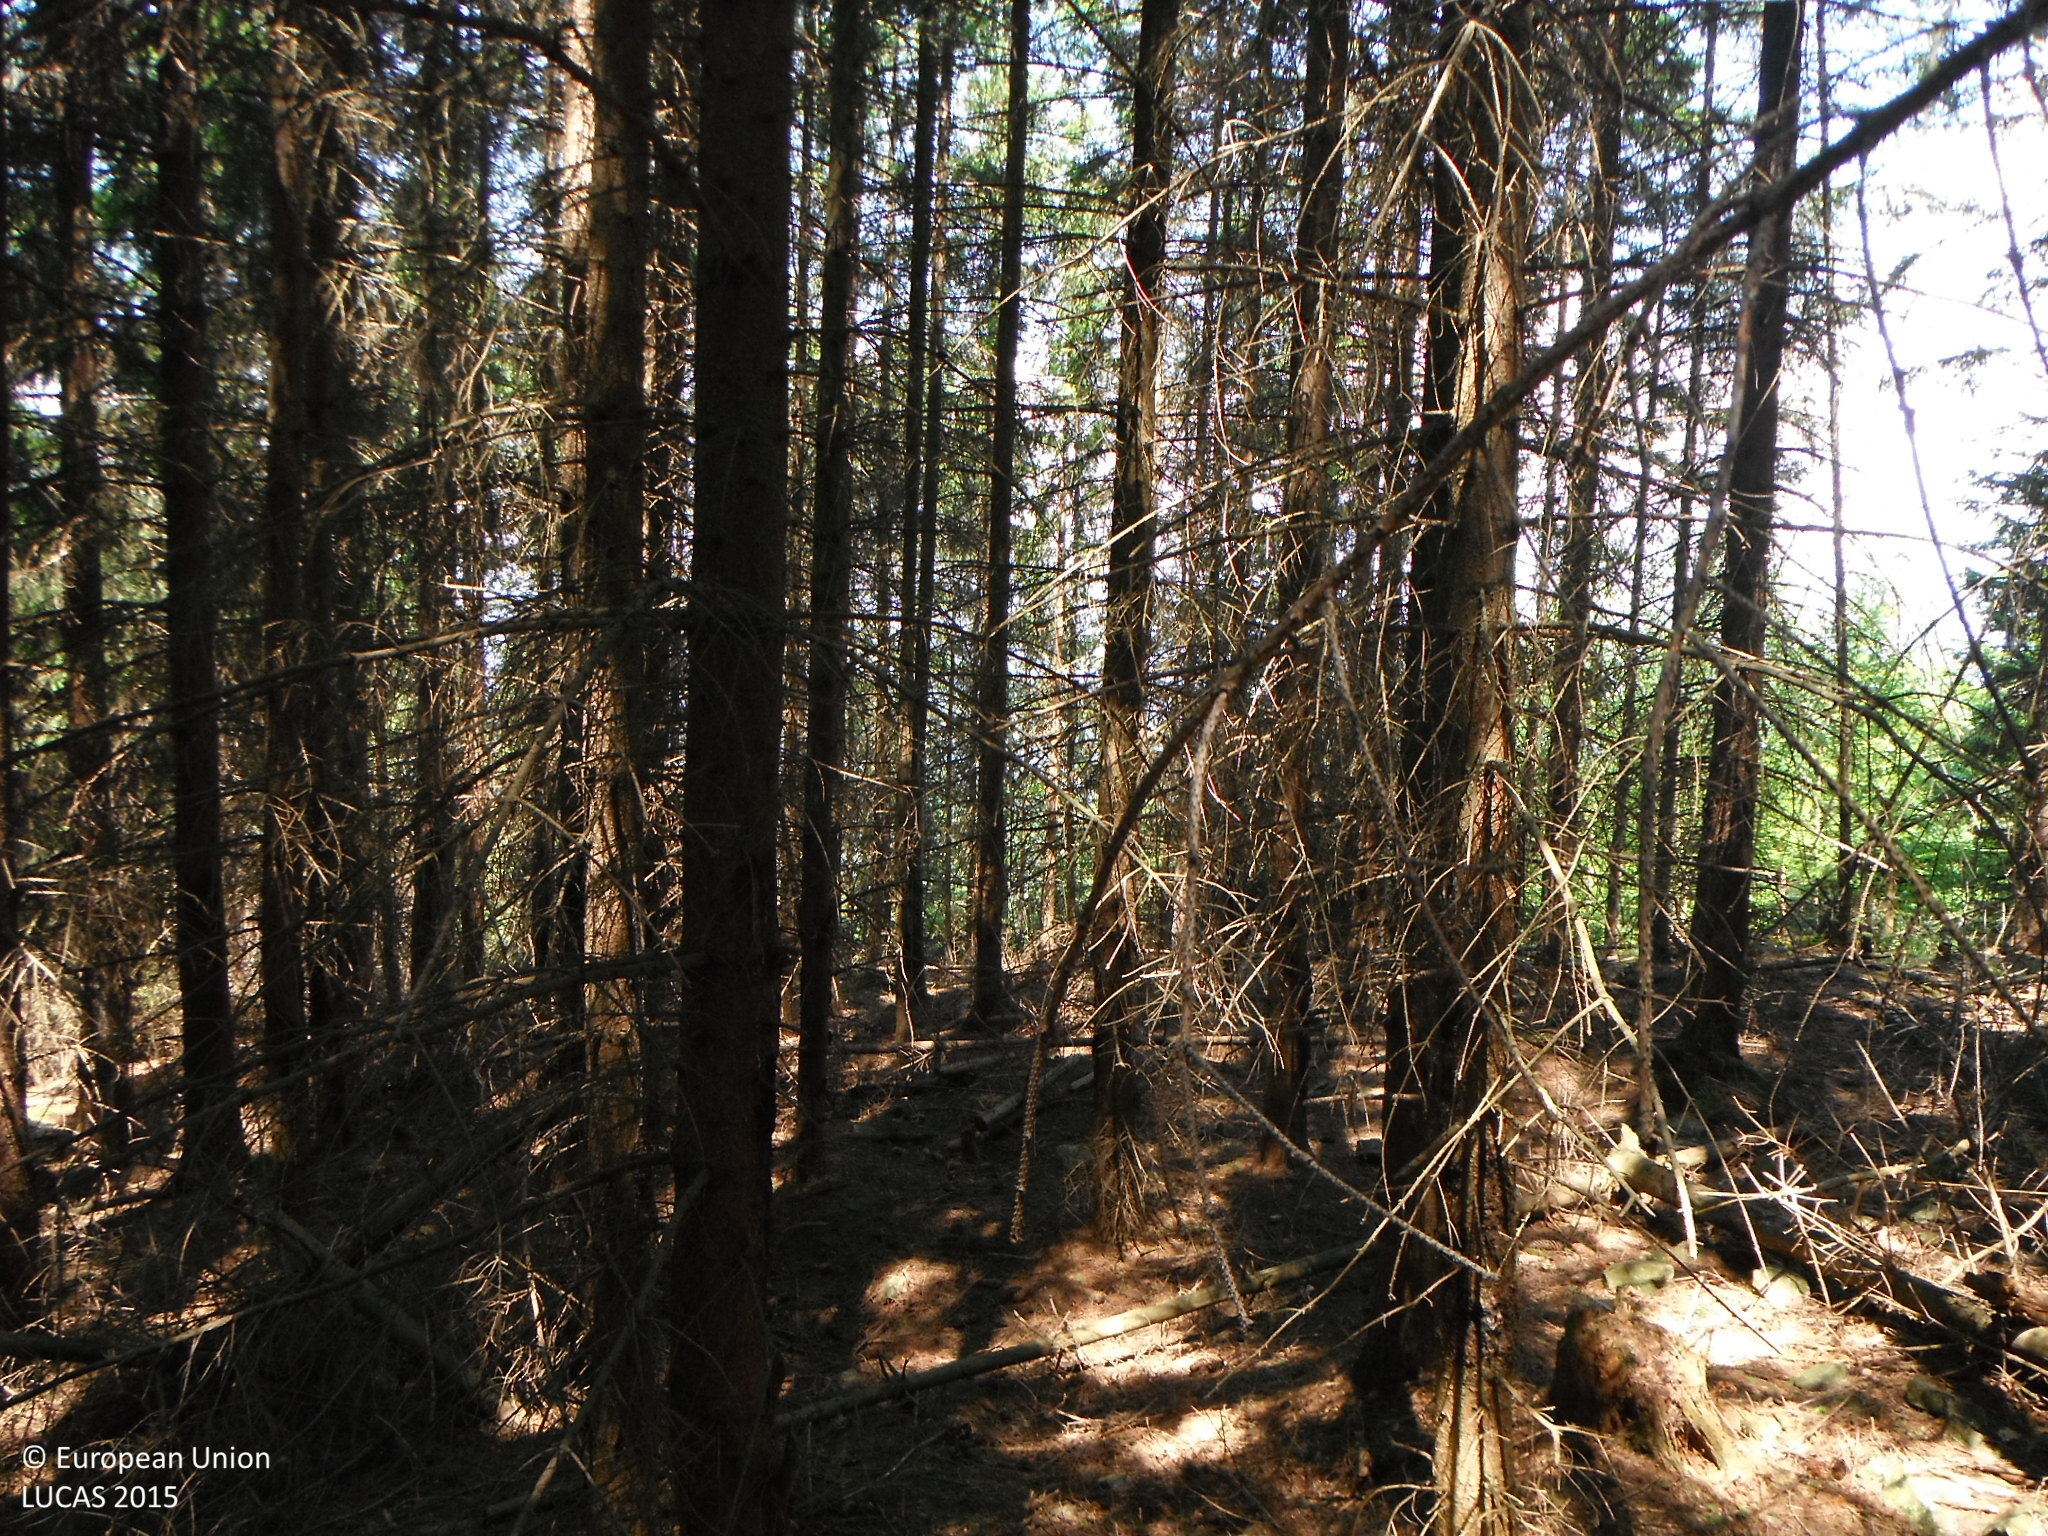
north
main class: Woodland
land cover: Spruce dominated coniferous woodland
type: alpine coniferous forest
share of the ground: > 75 %
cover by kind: coniferous forest trees 100 %
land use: Forestry
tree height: > 5 m
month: June
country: SK
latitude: 48.7142
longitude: 19.3338
